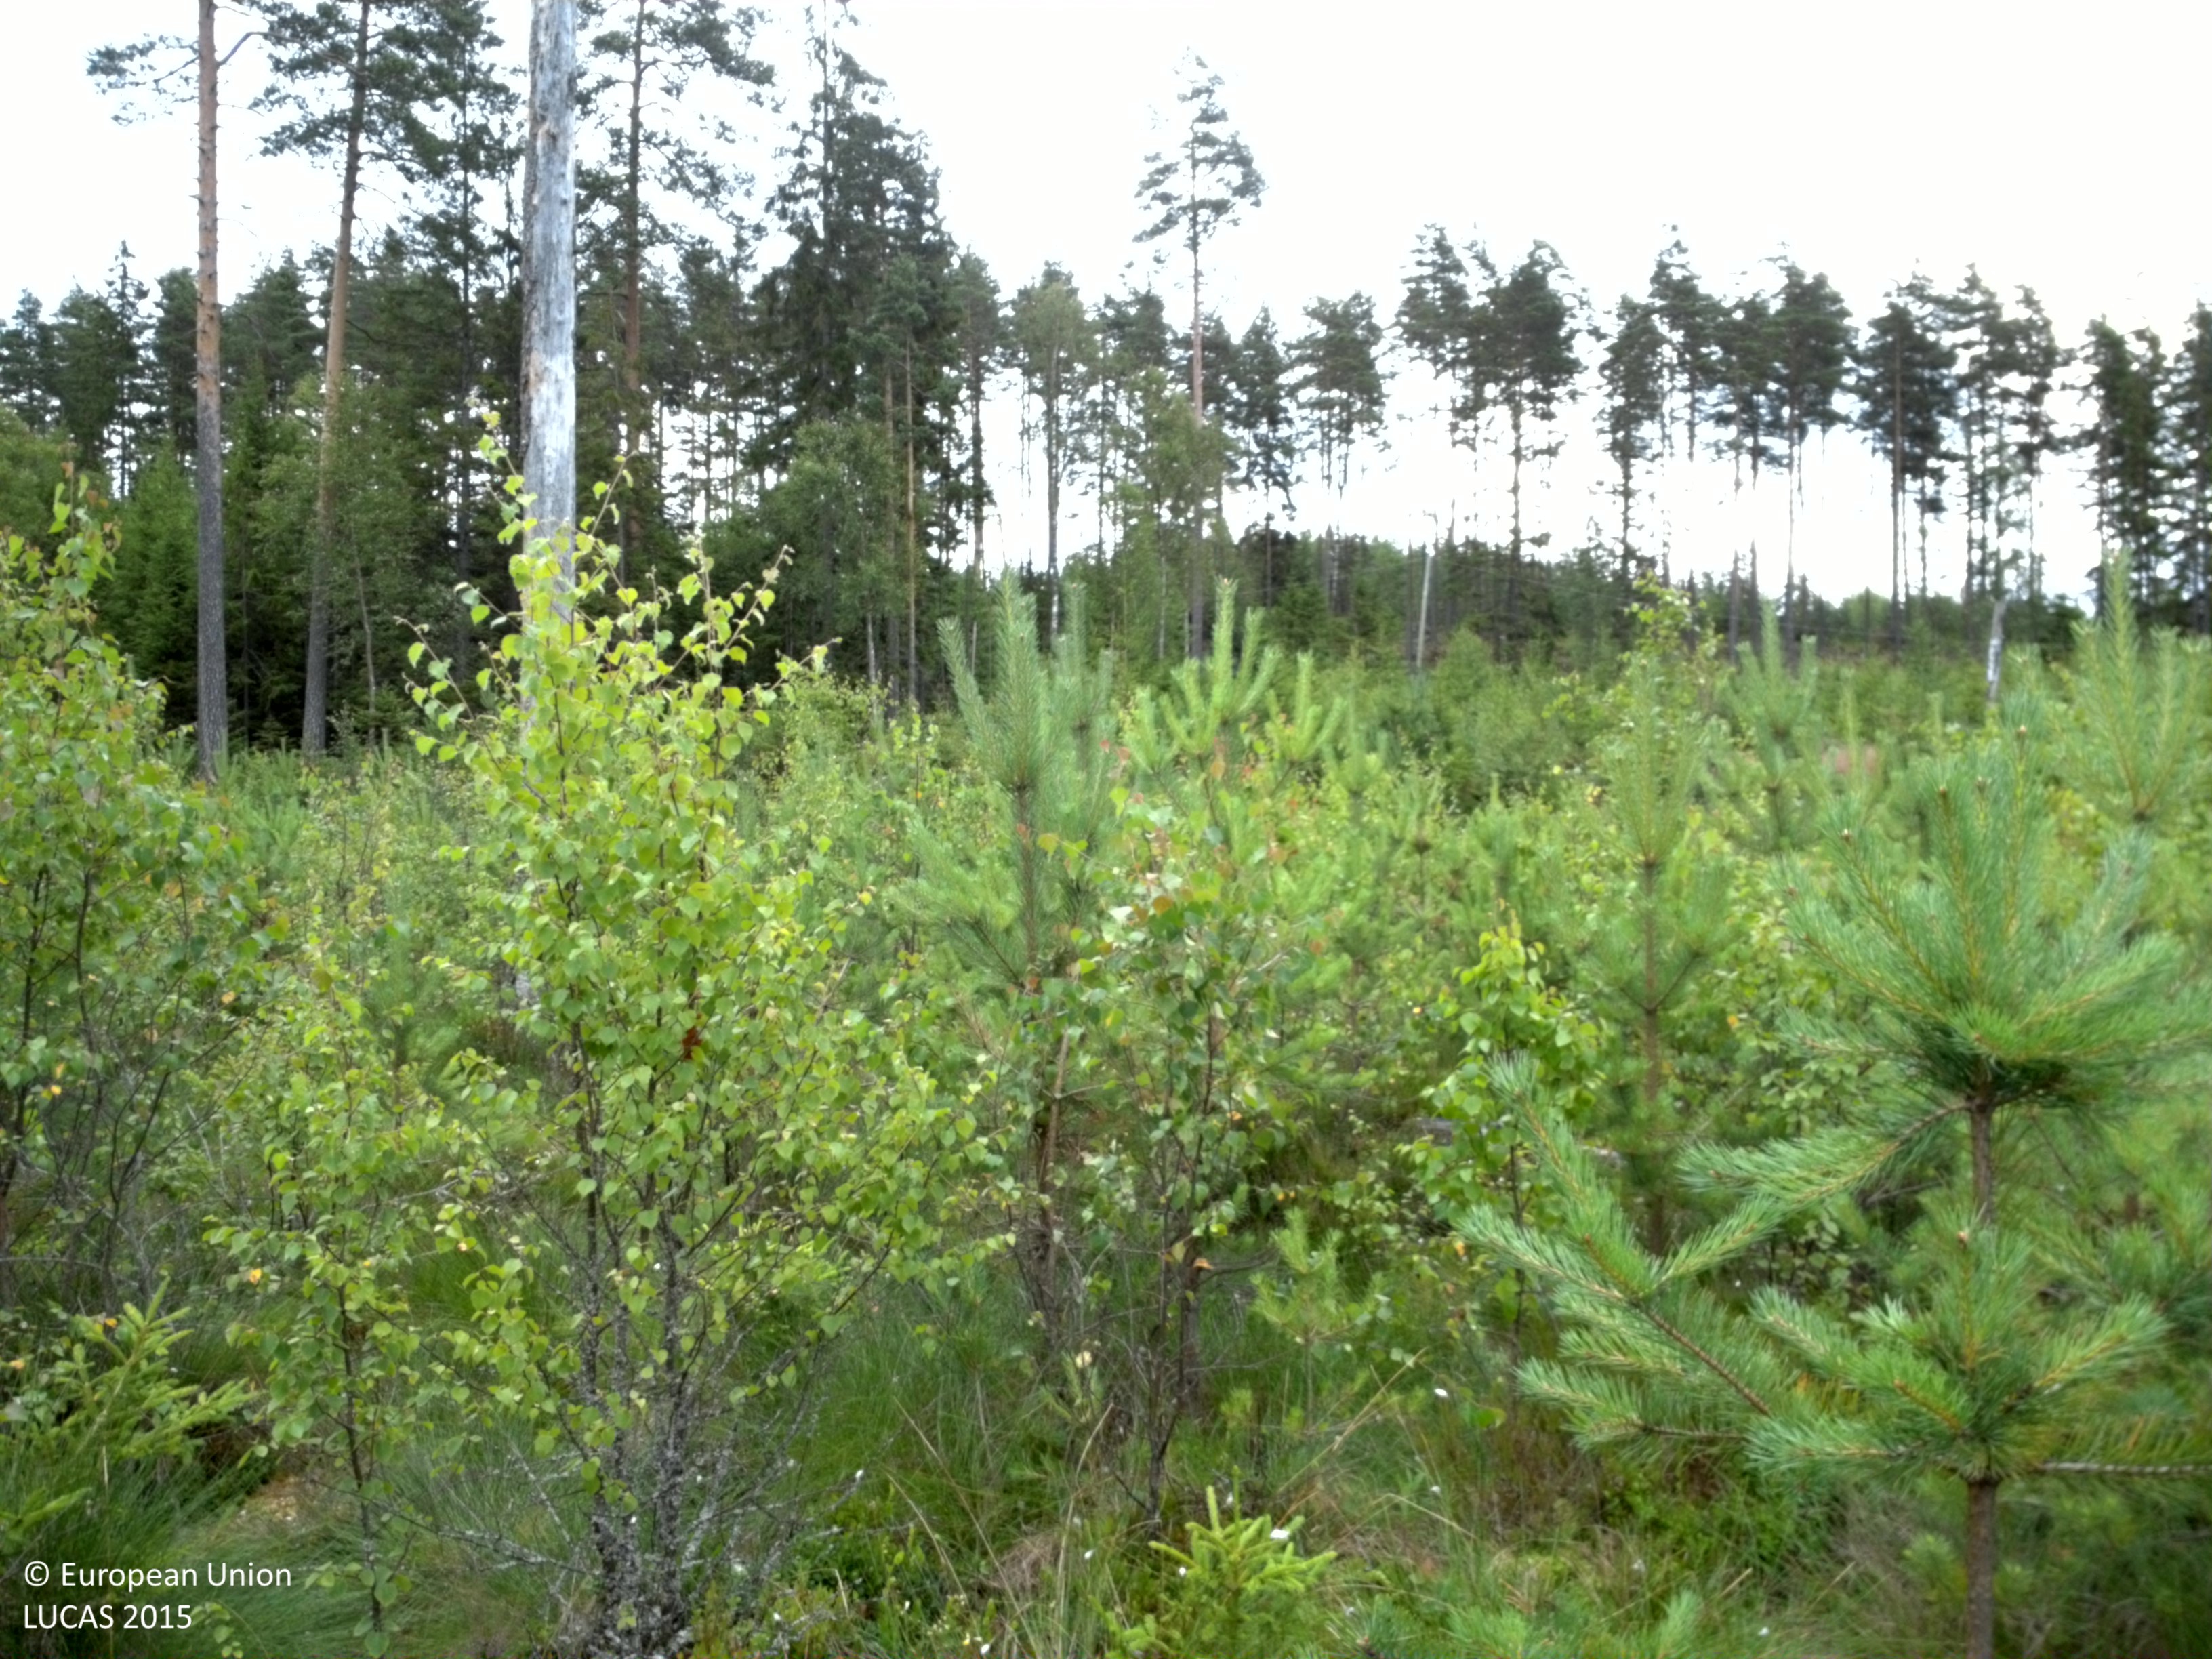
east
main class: Woodland
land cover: Pine dominated mixed woodland
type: boreal forest
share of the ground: 50 - 75 %
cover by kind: coniferous forest trees 45 %, broadleaved forest trees 25 %, herbaceous plants 25 %, shrubs 5 %
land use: Forestry
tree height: > 5 m
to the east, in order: Pine dominated mixed woodland; Other mixed woodland; Paved roads, cycling and walking lanes; Pine dominated mixed woodland; Tracks; Other mixed woodland; Pine dominated mixed woodland
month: July
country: SE
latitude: 58.9542
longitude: 14.5297
